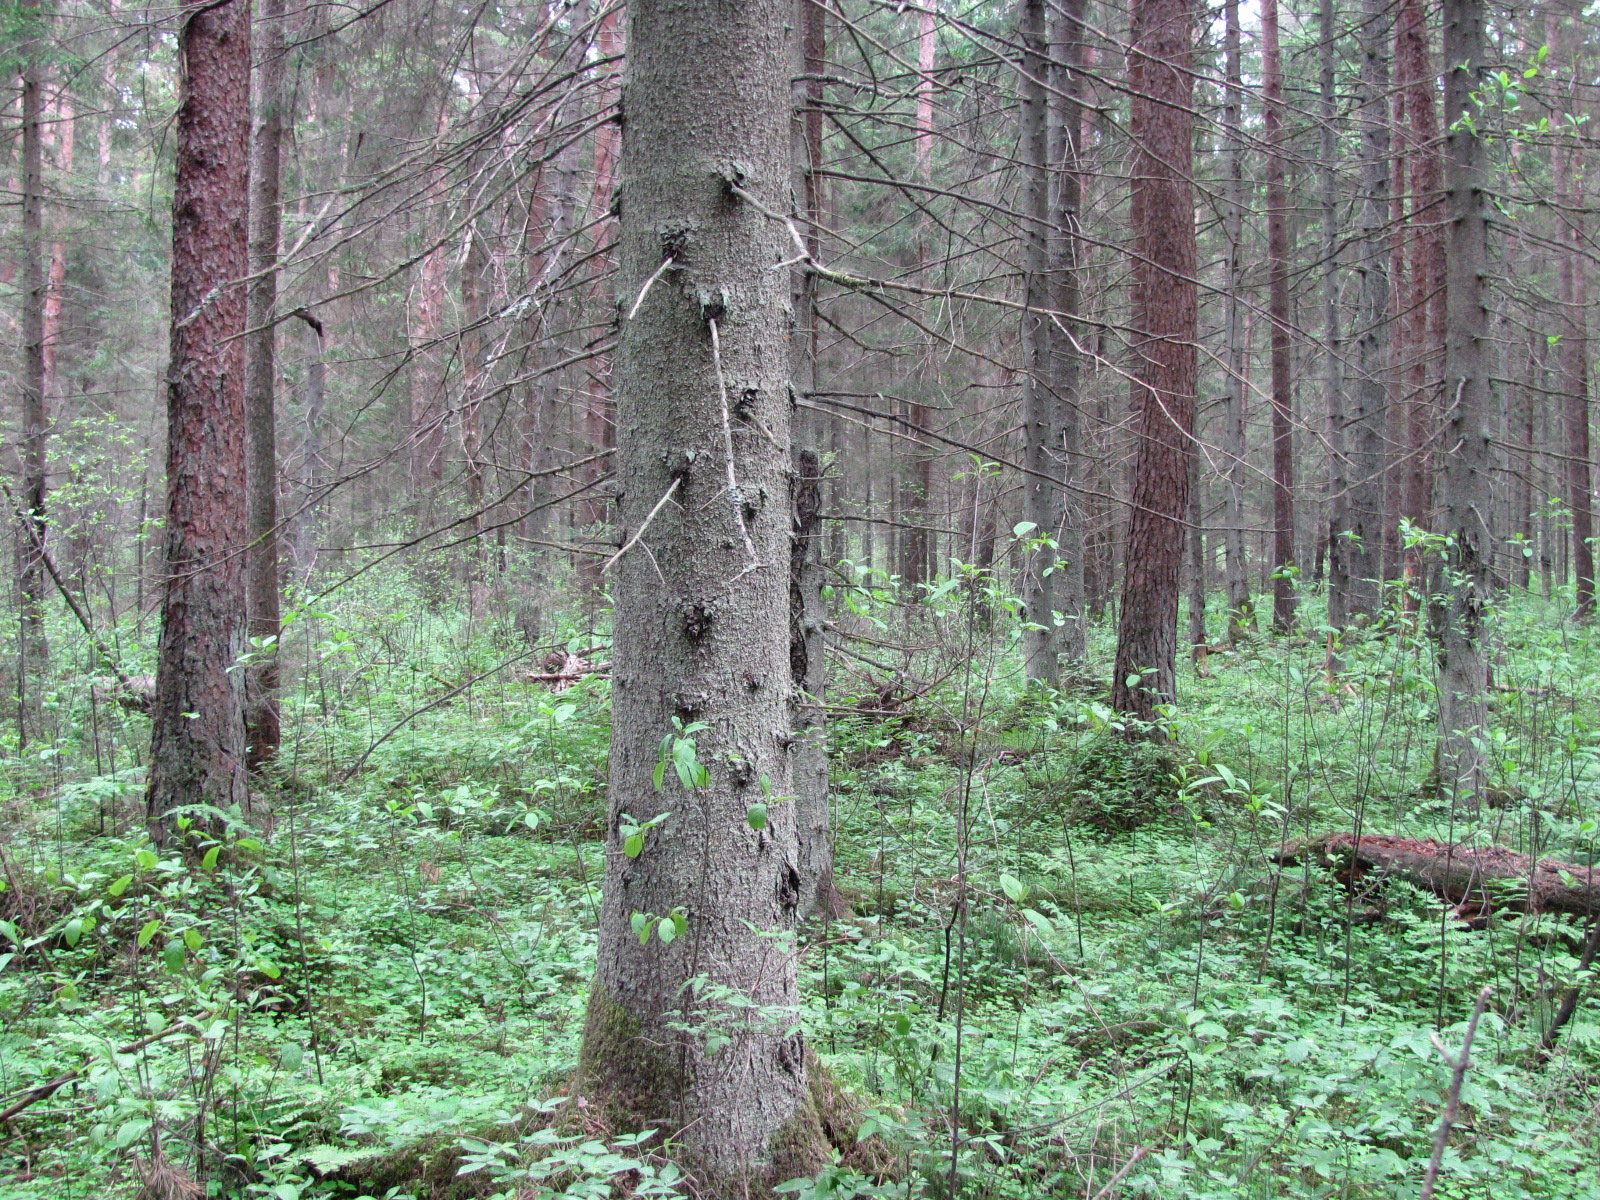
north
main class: Woodland
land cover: Other coniferous woodland
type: hemiboreal forest and nemoral coniferous forest and mixed broadleaved-coniferous forest
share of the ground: > 75 %
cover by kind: coniferous forest trees 100 %
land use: Forestry
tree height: > 5 m
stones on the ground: < 10 %
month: June
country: LV
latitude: 56.8271
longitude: 24.1298
